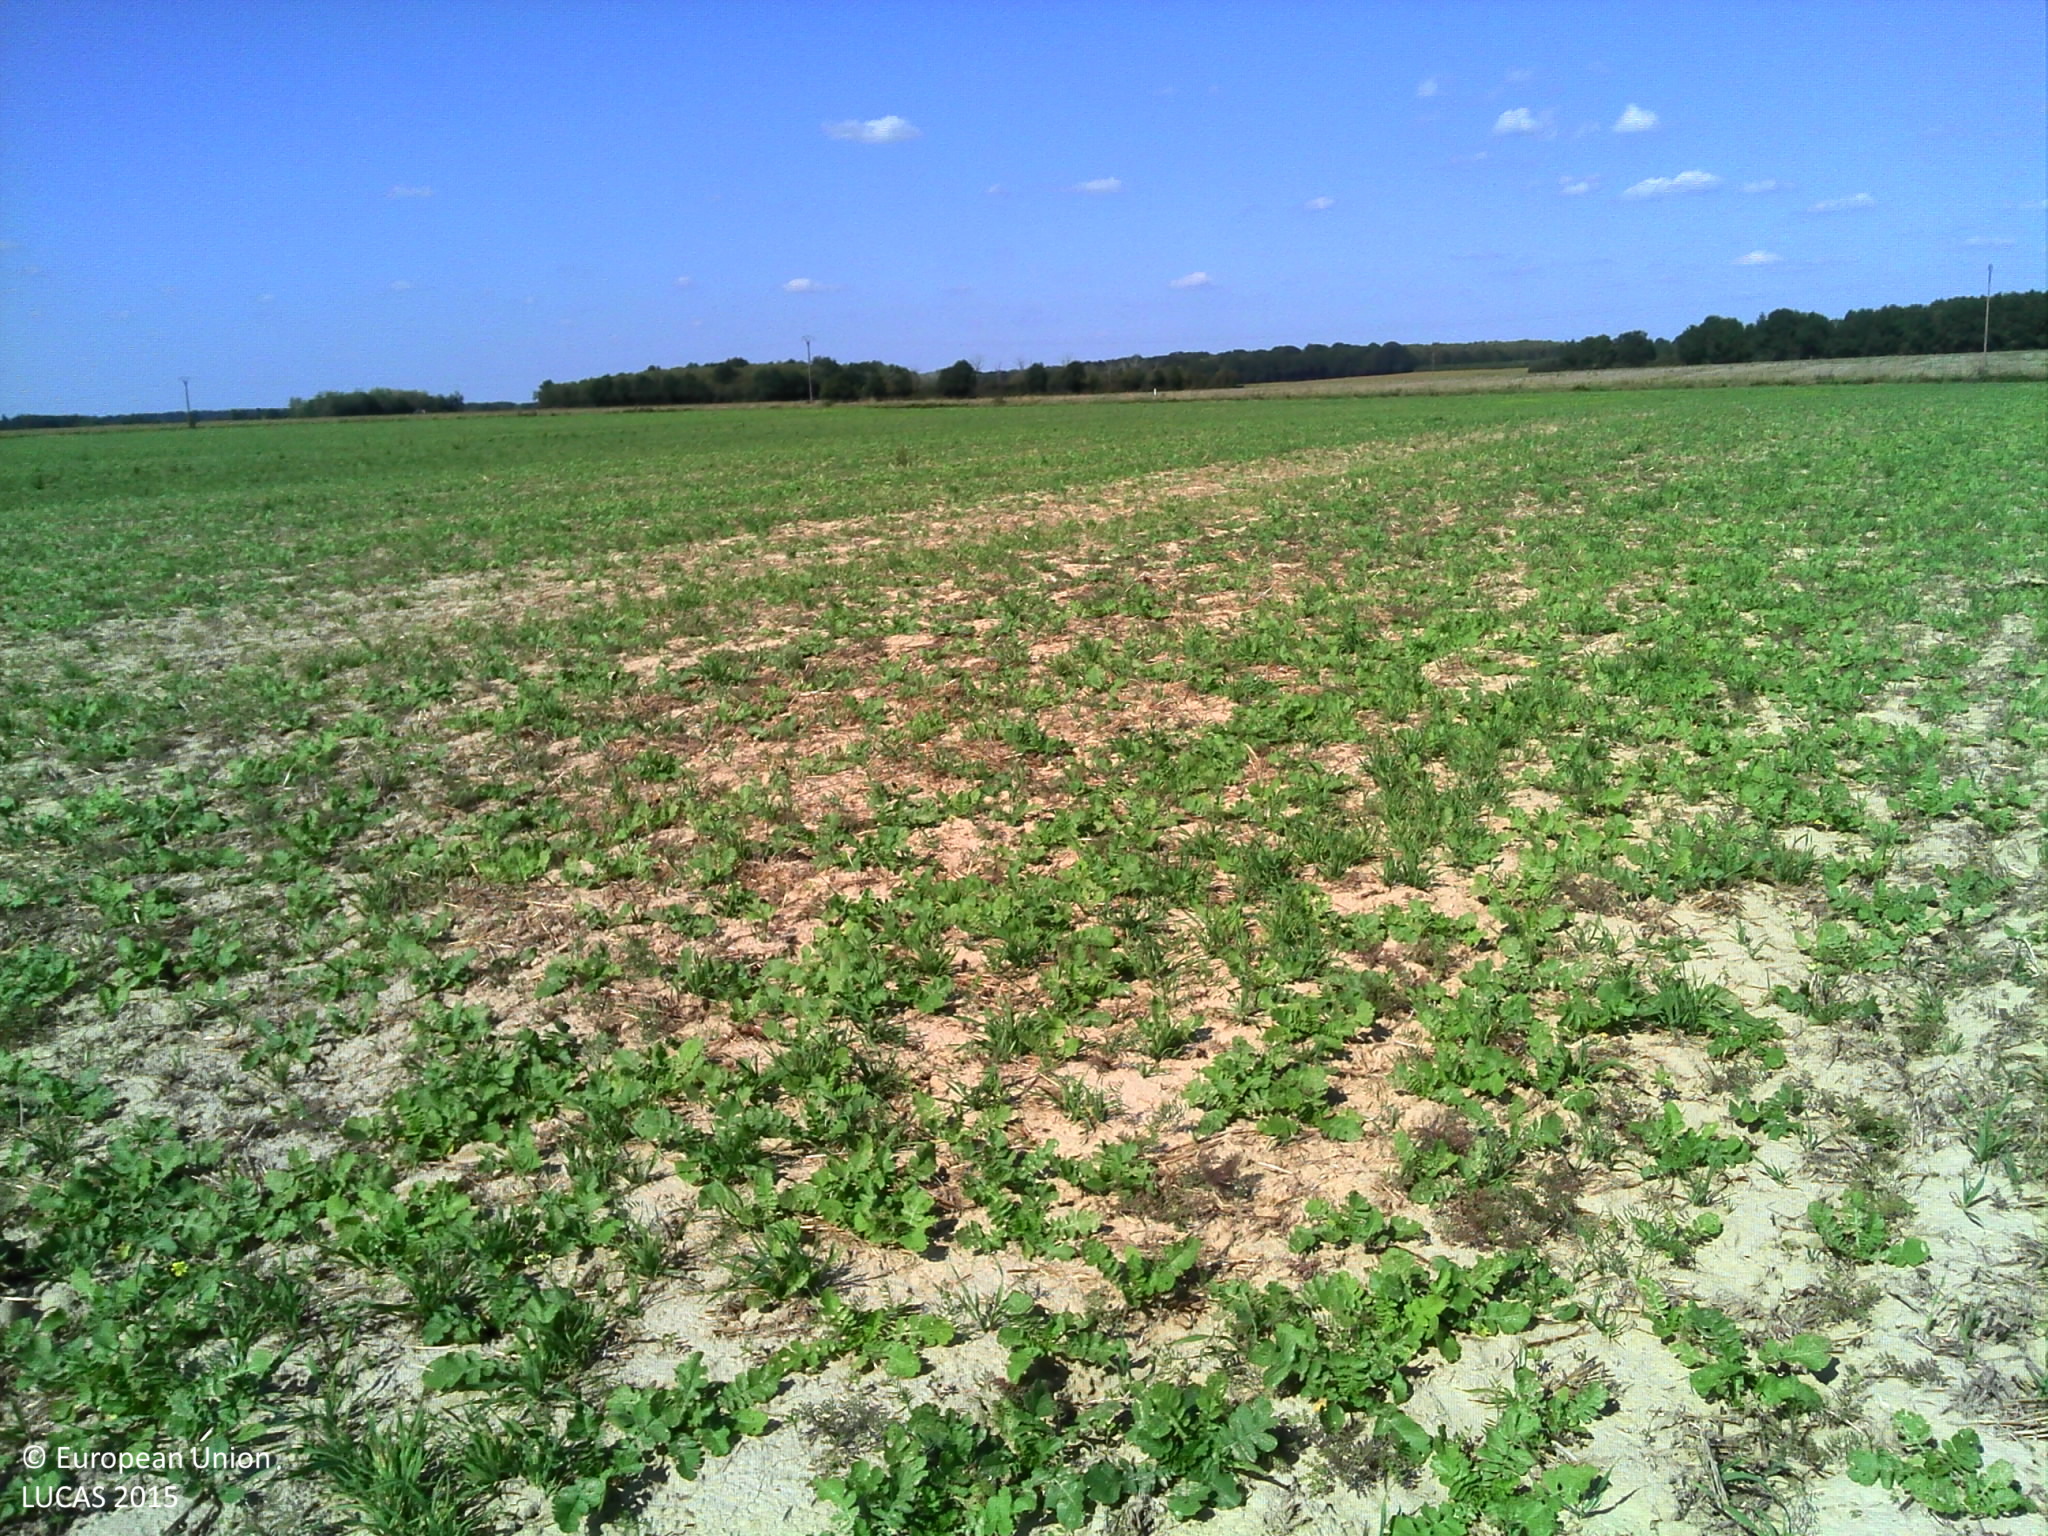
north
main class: Cropland
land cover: Other root crops
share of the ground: < 10 %
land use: Agriculture (excluding fallow land and kitchen gardens)
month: September
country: FR
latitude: 47.1156
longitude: 1.4866
